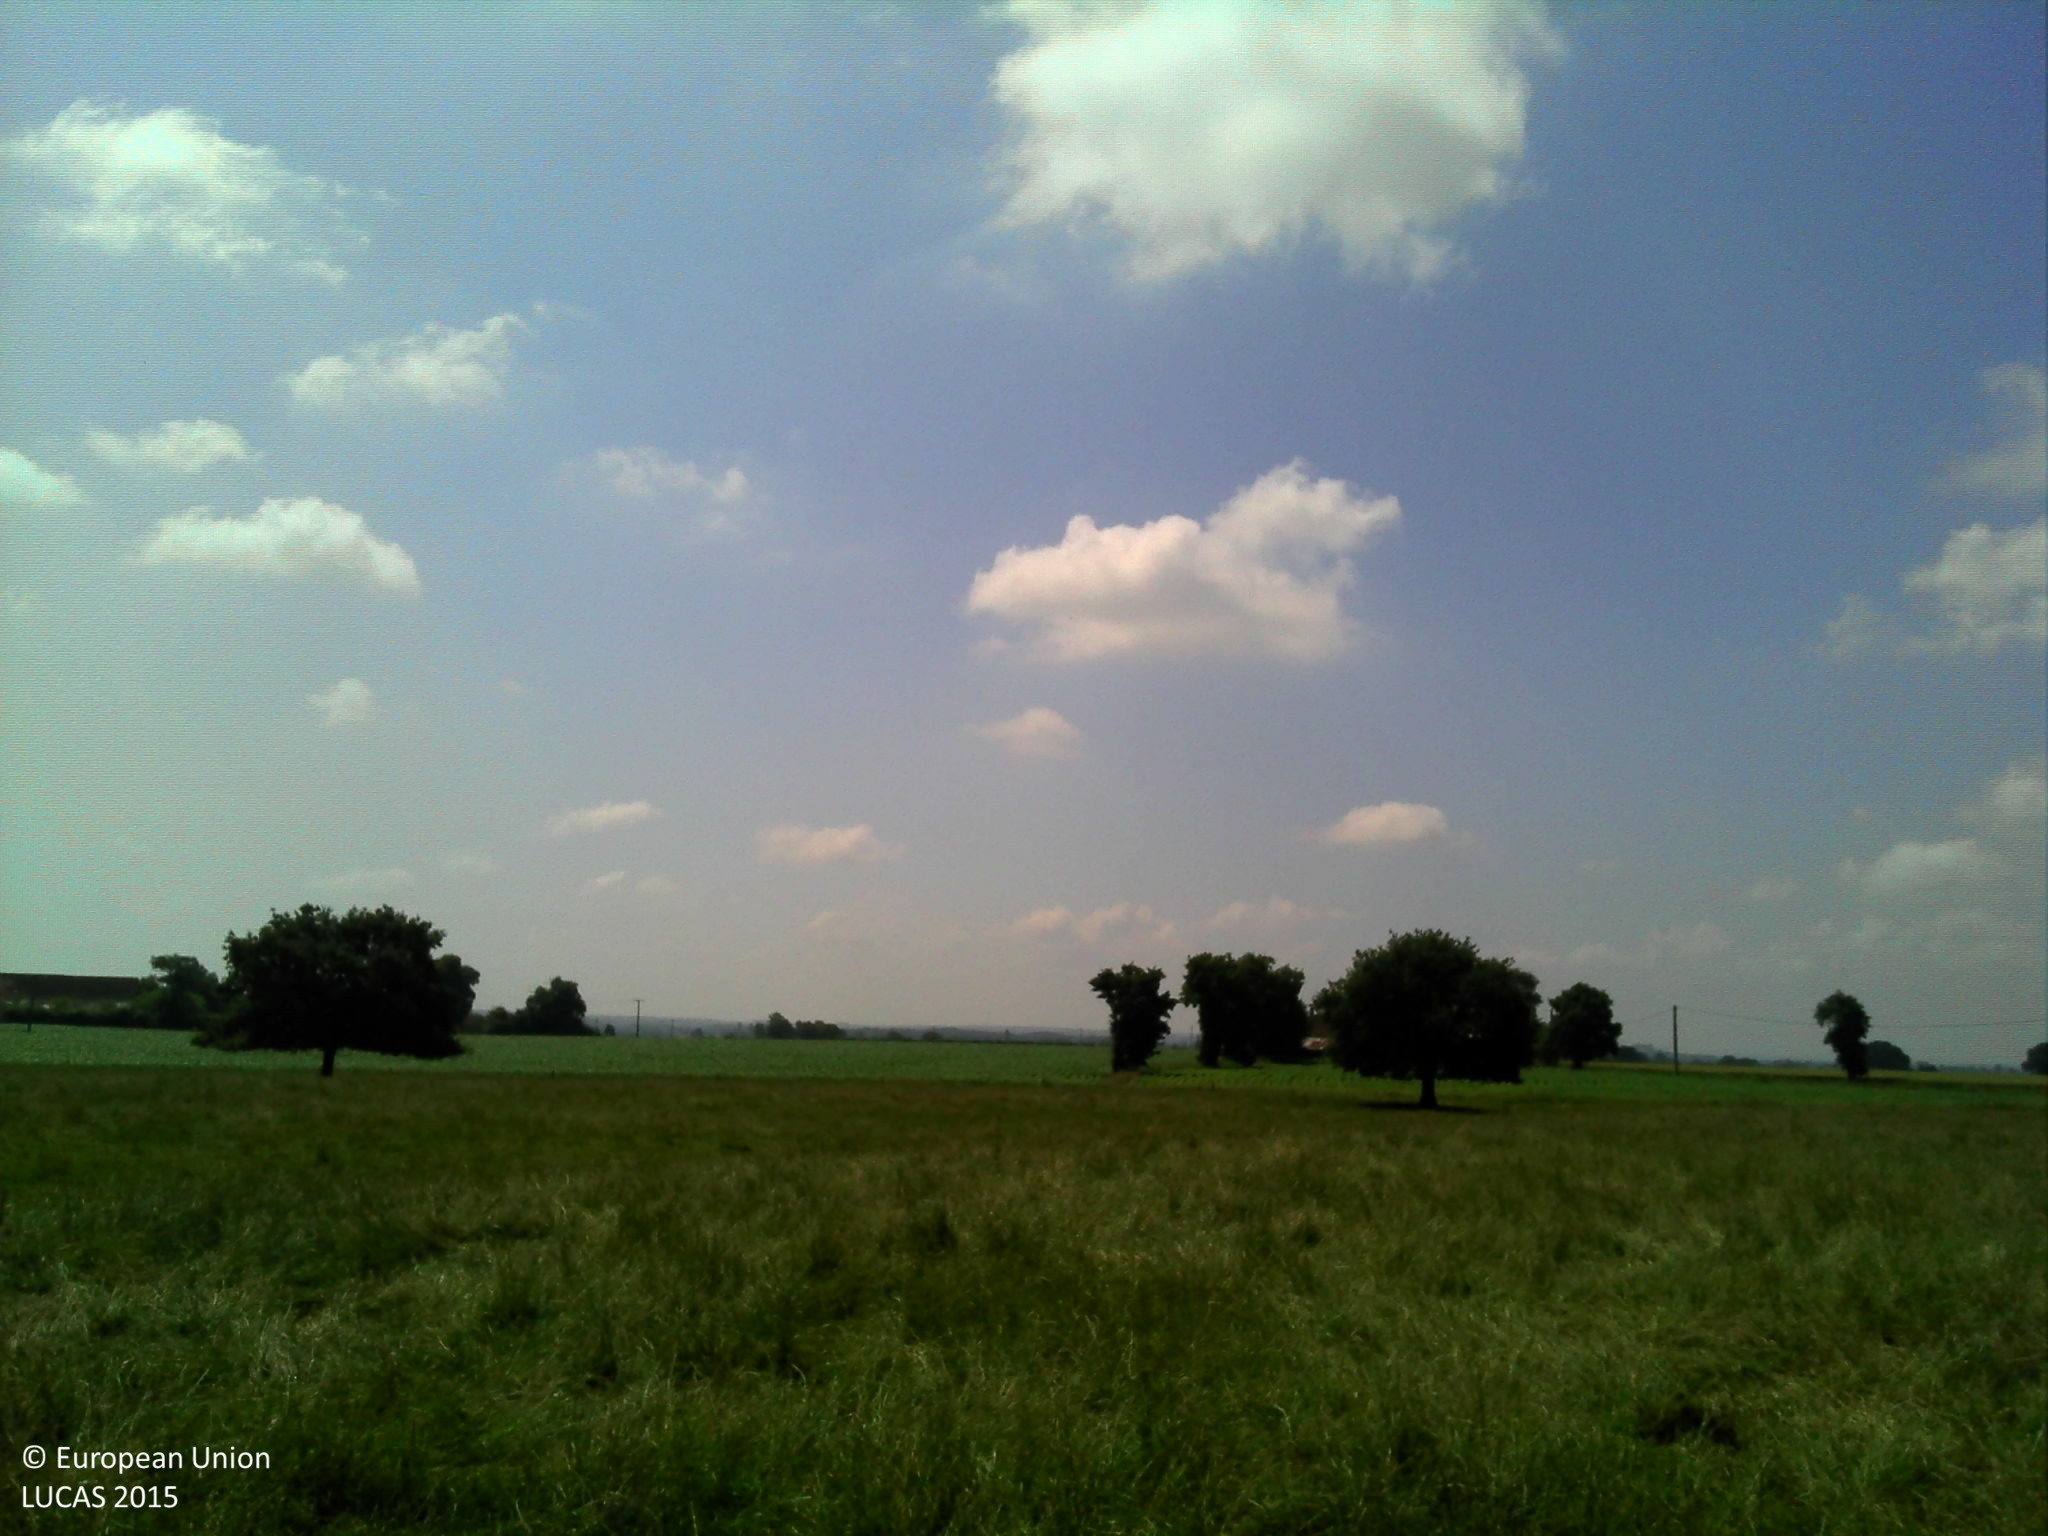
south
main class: Grassland
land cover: Grassland without tree/shrub cover
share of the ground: > 75 %
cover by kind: herbaceous plants 100 %
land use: Agriculture (excluding fallow land and kitchen gardens)
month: June
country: FR
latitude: 48.2448
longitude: 0.2646
